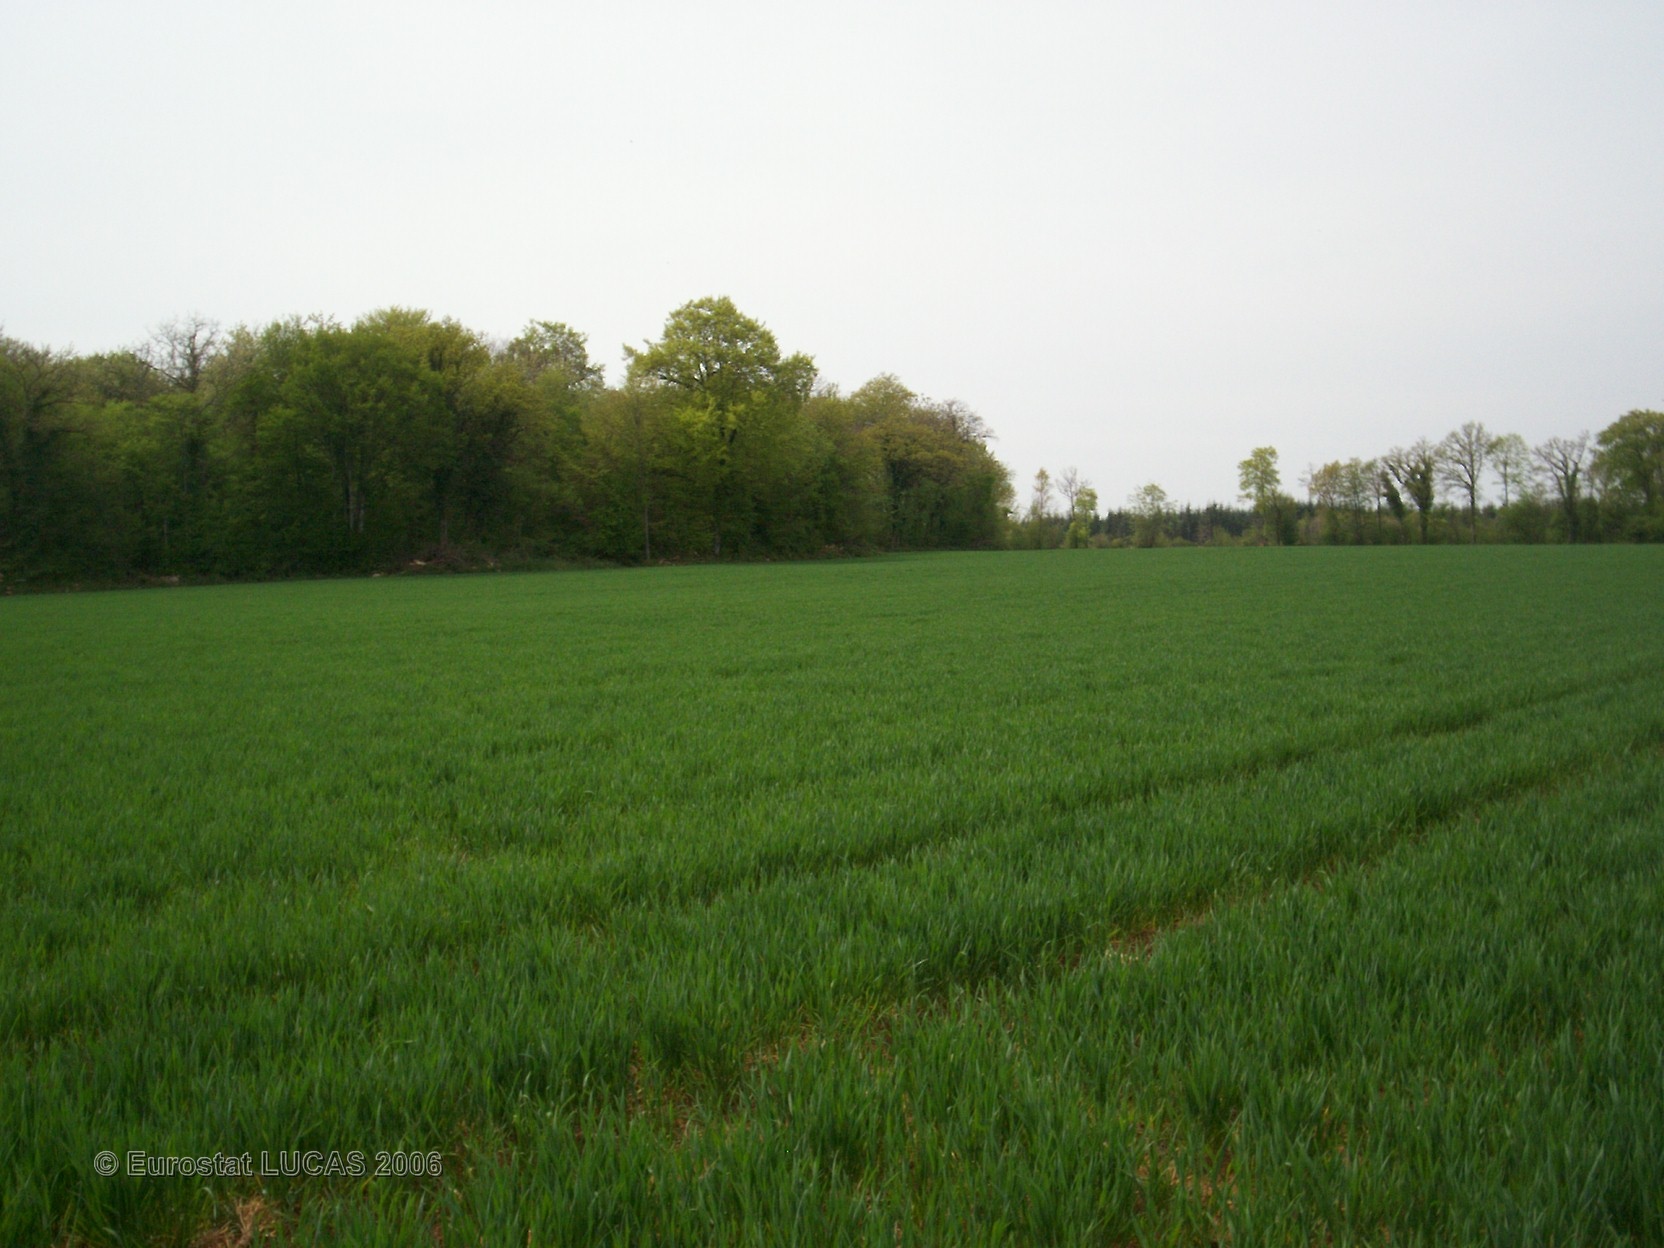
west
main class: Cropland
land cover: Common wheat
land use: Agriculture (excluding fallow land and kitchen gardens)
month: May
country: FR
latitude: 47.6932
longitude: 4.5760
